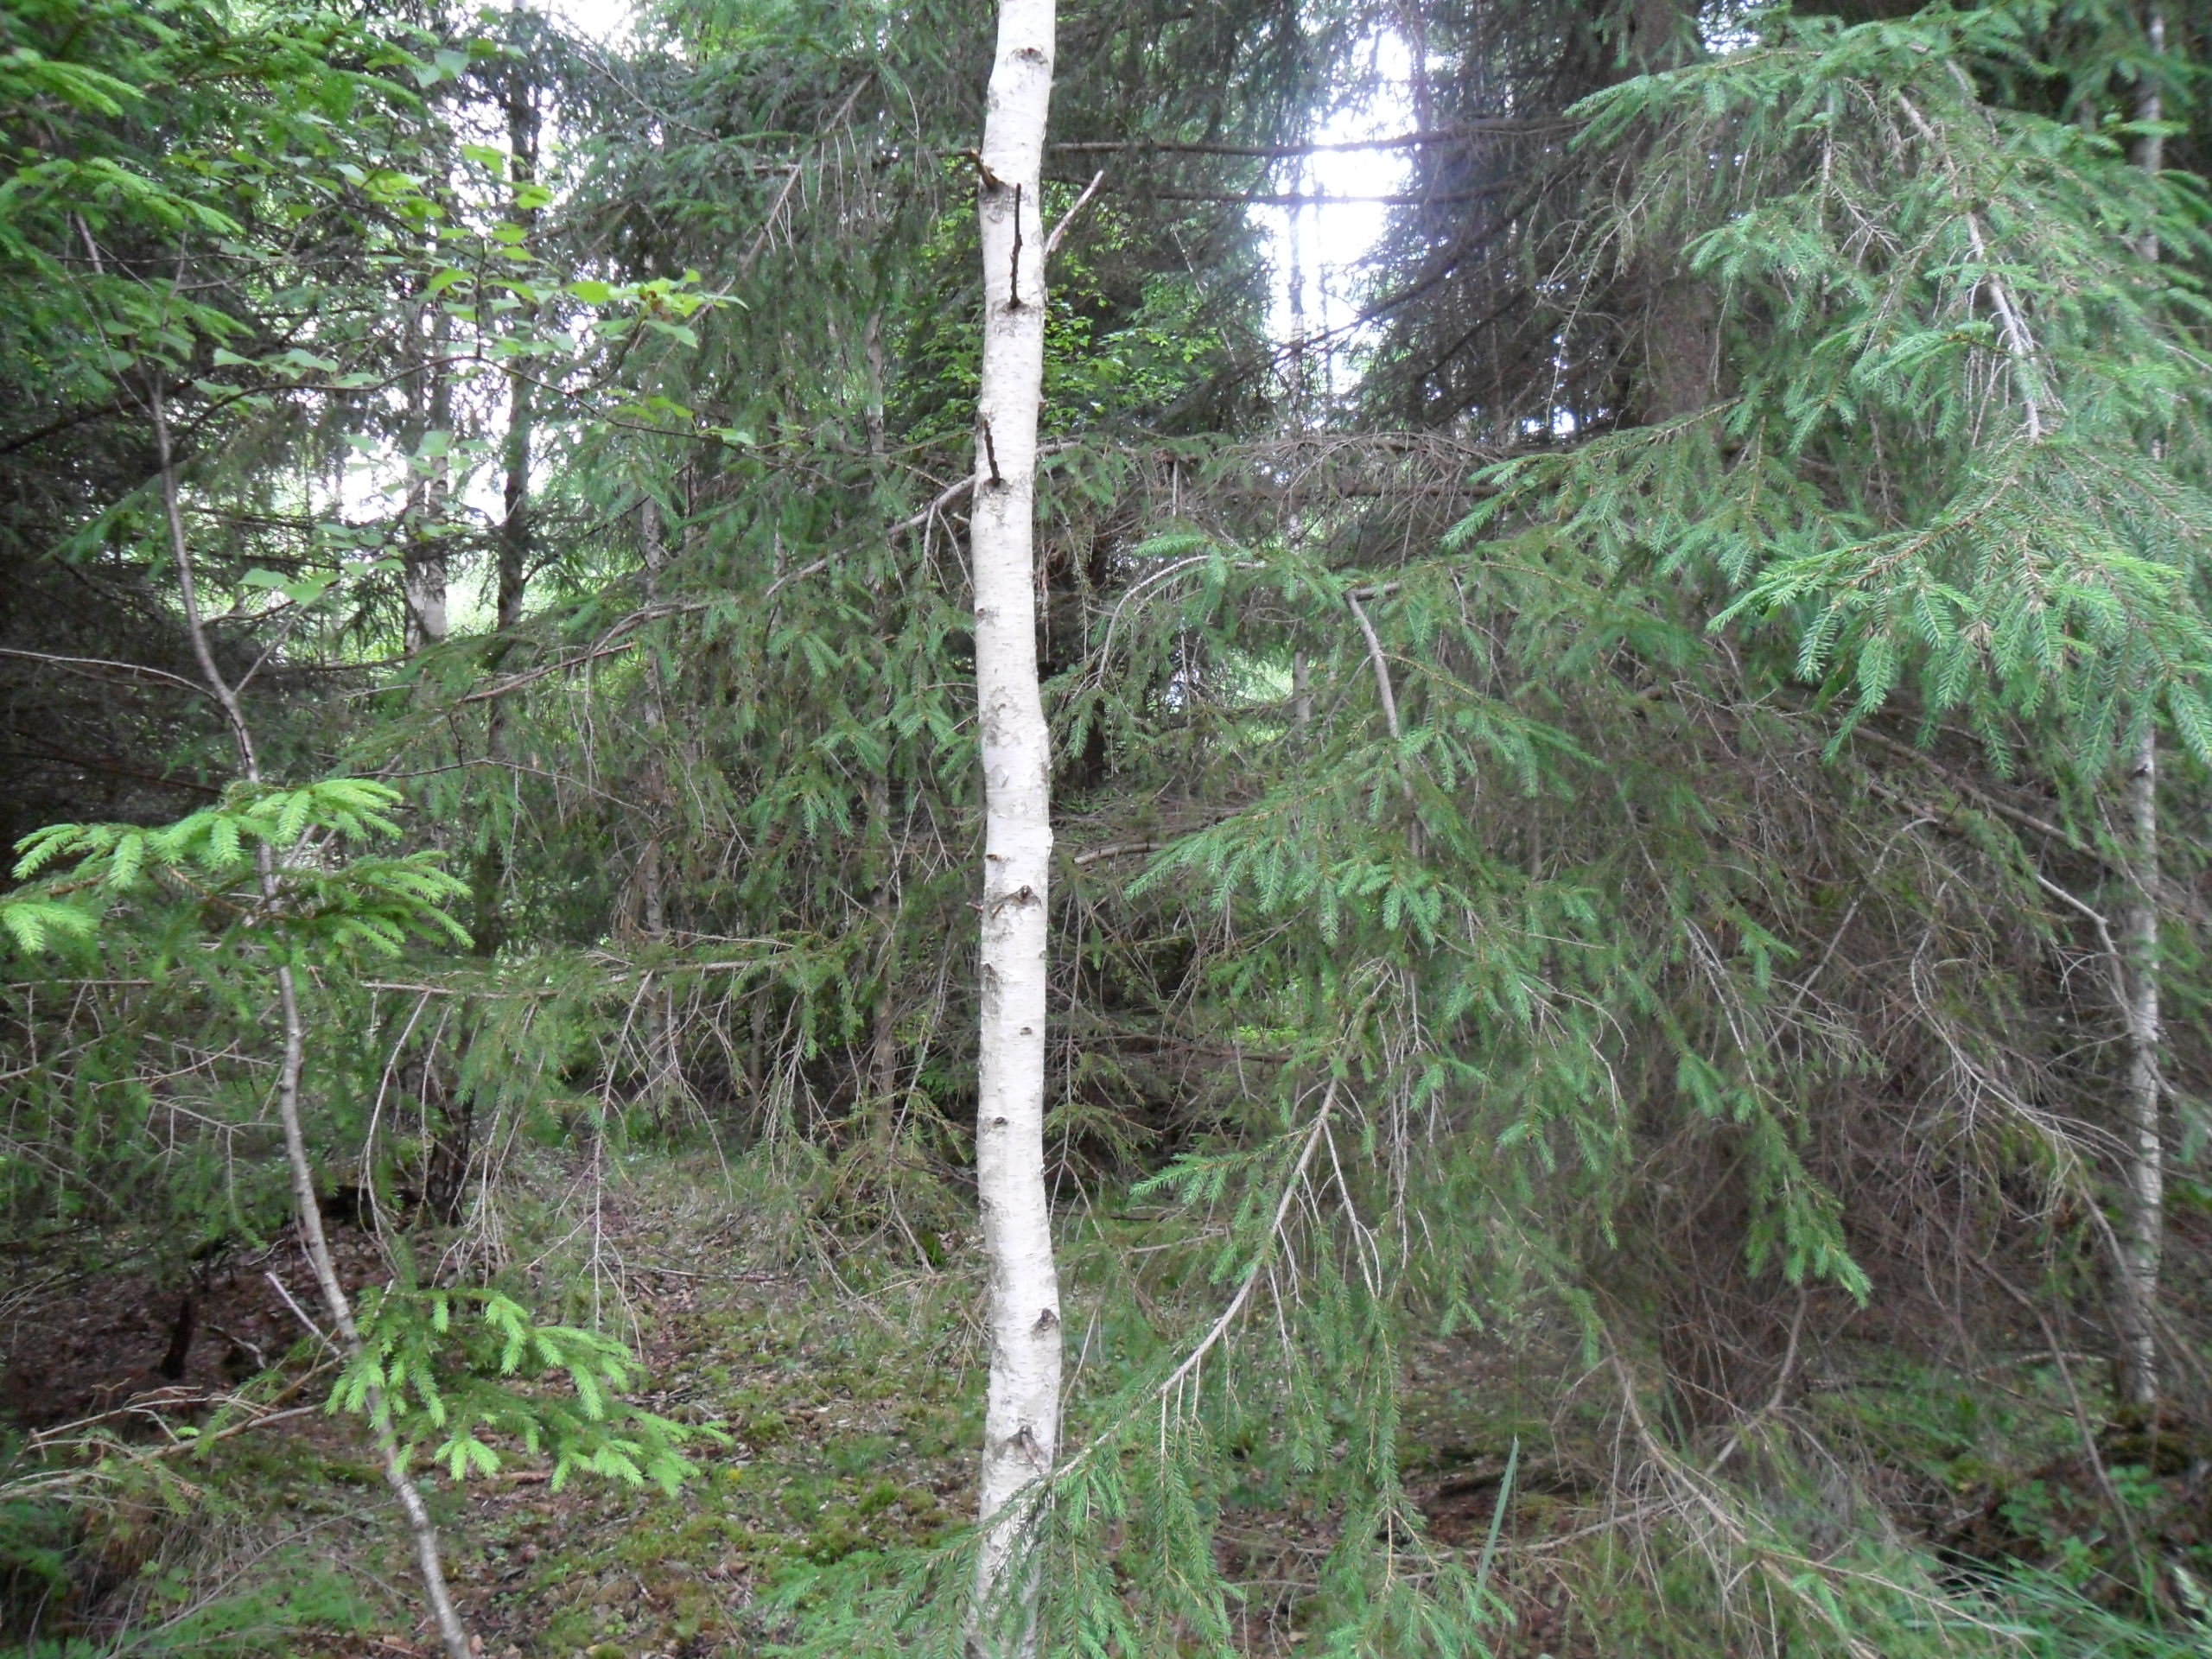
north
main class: Woodland
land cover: Spruce dominated mixed woodland
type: hemiboreal forest and nemoral coniferous forest and mixed broadleaved-coniferous forest
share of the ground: 50 - 75 %
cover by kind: coniferous forest trees 35 %, broadleaved forest trees 35 %, herbaceous plants 20 %, shrubs 10 %
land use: Forestry
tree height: > 5 m
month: July
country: LV
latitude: 57.1409
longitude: 22.4979
